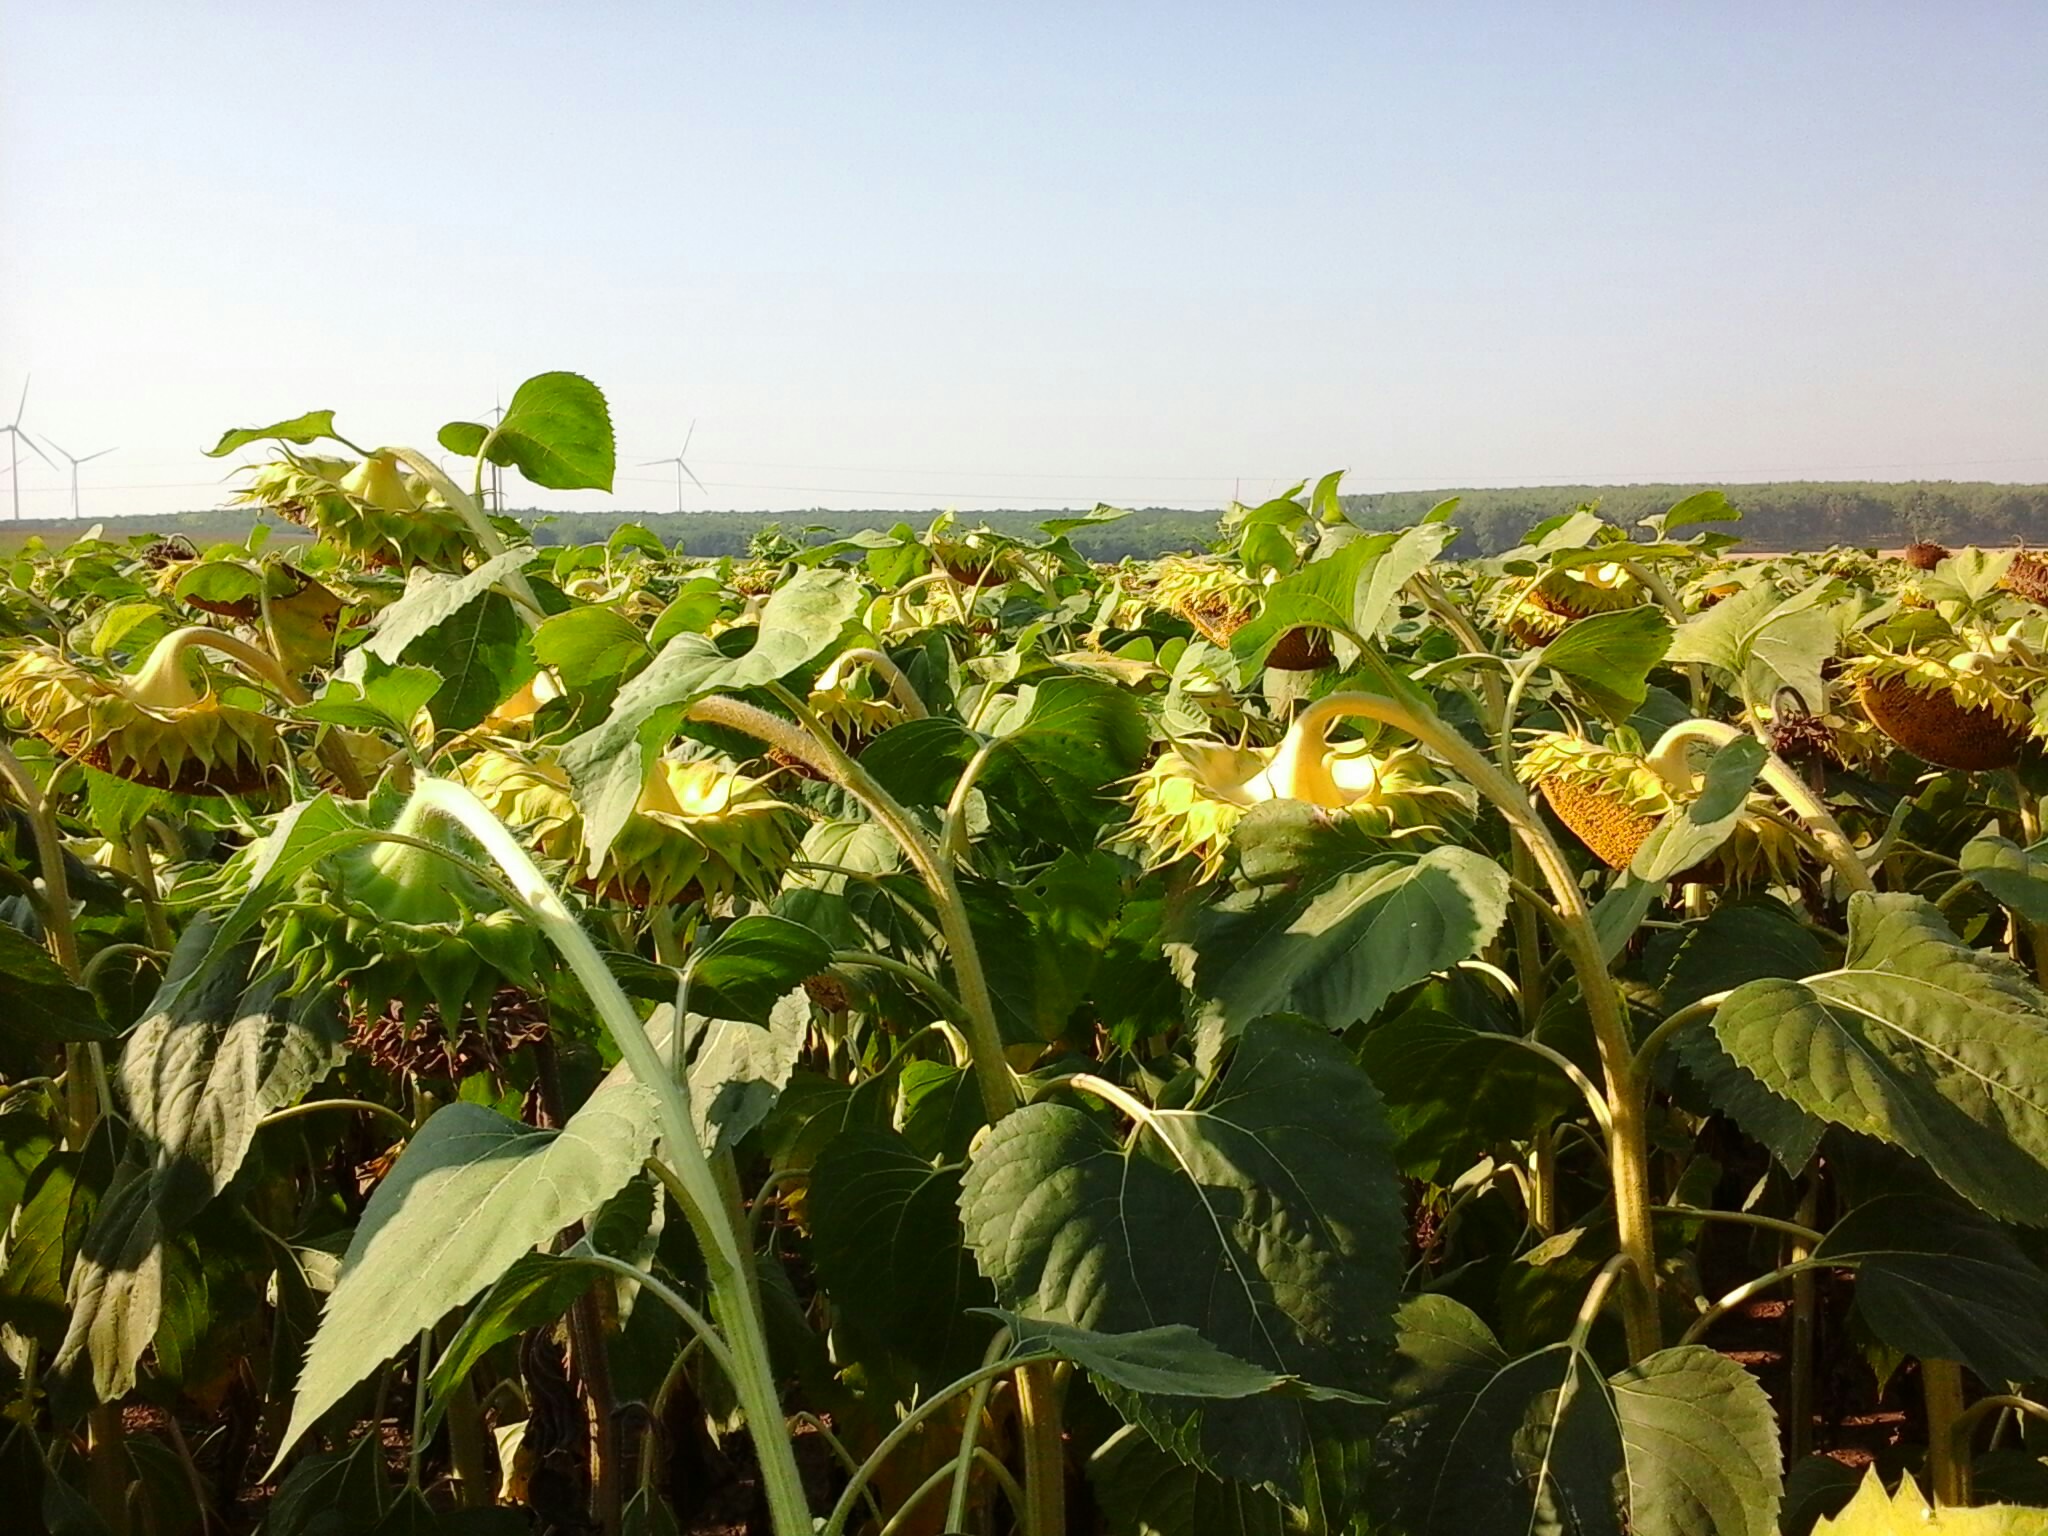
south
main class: Cropland
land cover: Sunflower
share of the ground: > 75 %
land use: Agriculture (excluding fallow land and kitchen gardens)
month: August
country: HU
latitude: 47.6801
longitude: 17.9903
